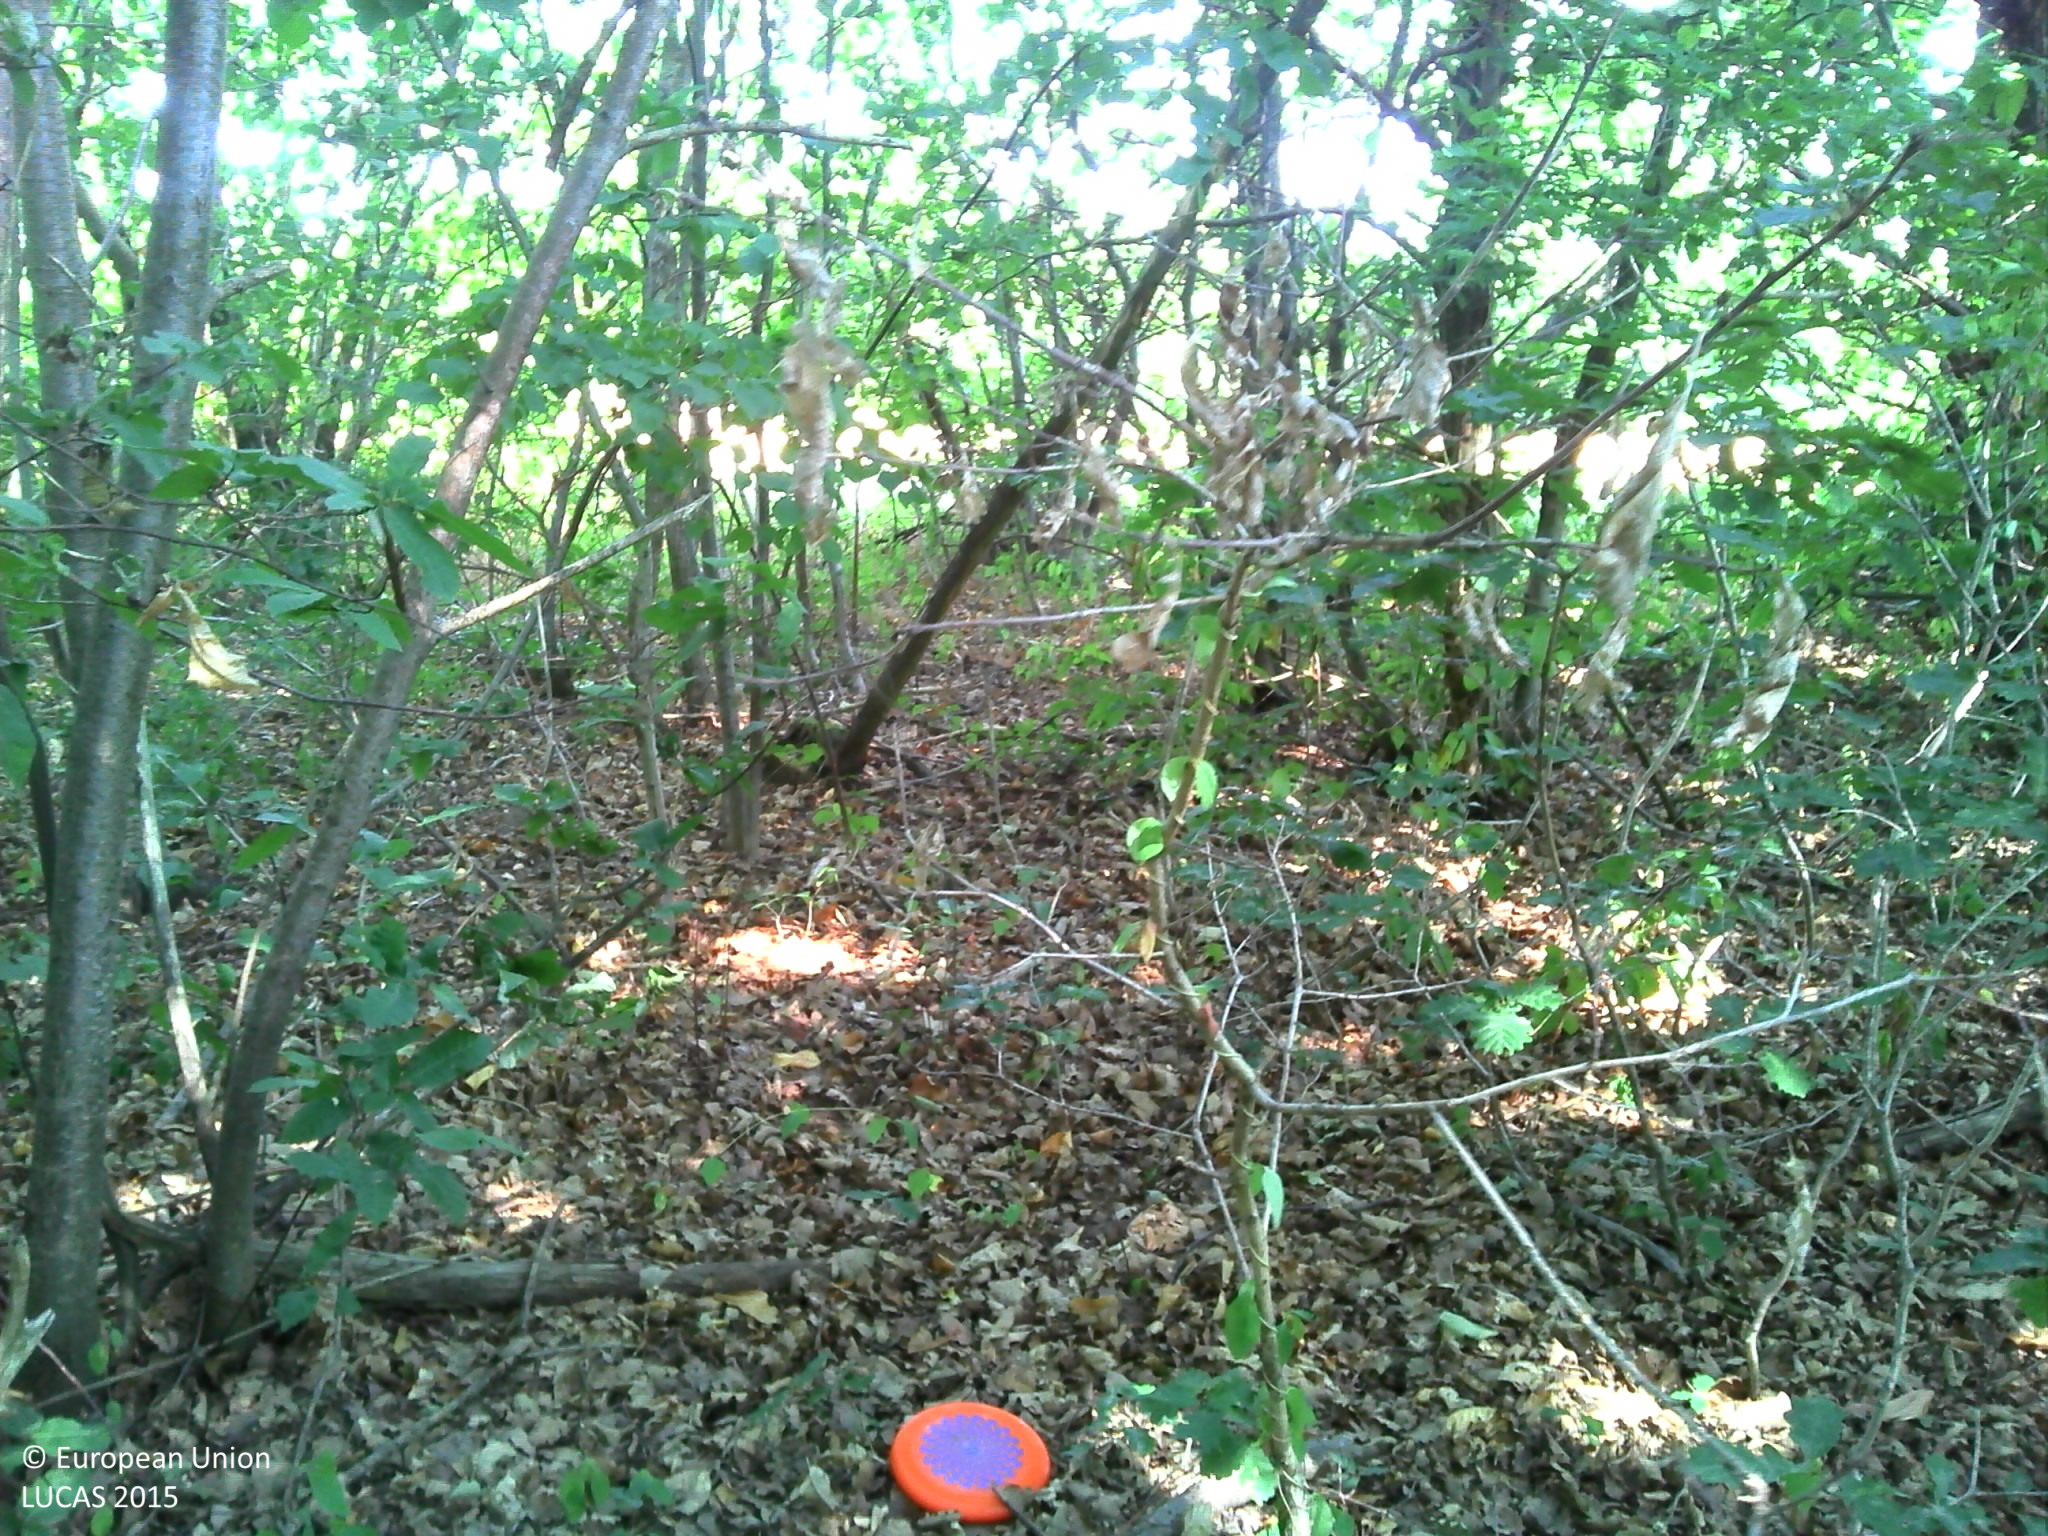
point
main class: Woodland
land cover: Broadleaved woodland
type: mesophytic deciduous forest
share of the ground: > 75 %
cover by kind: broadleaved forest trees 90 %, herbaceous plants 5 %, consolidated bare surface 5 %
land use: Forestry
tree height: > 5 m
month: July
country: FR
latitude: 45.3984
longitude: 4.8819
